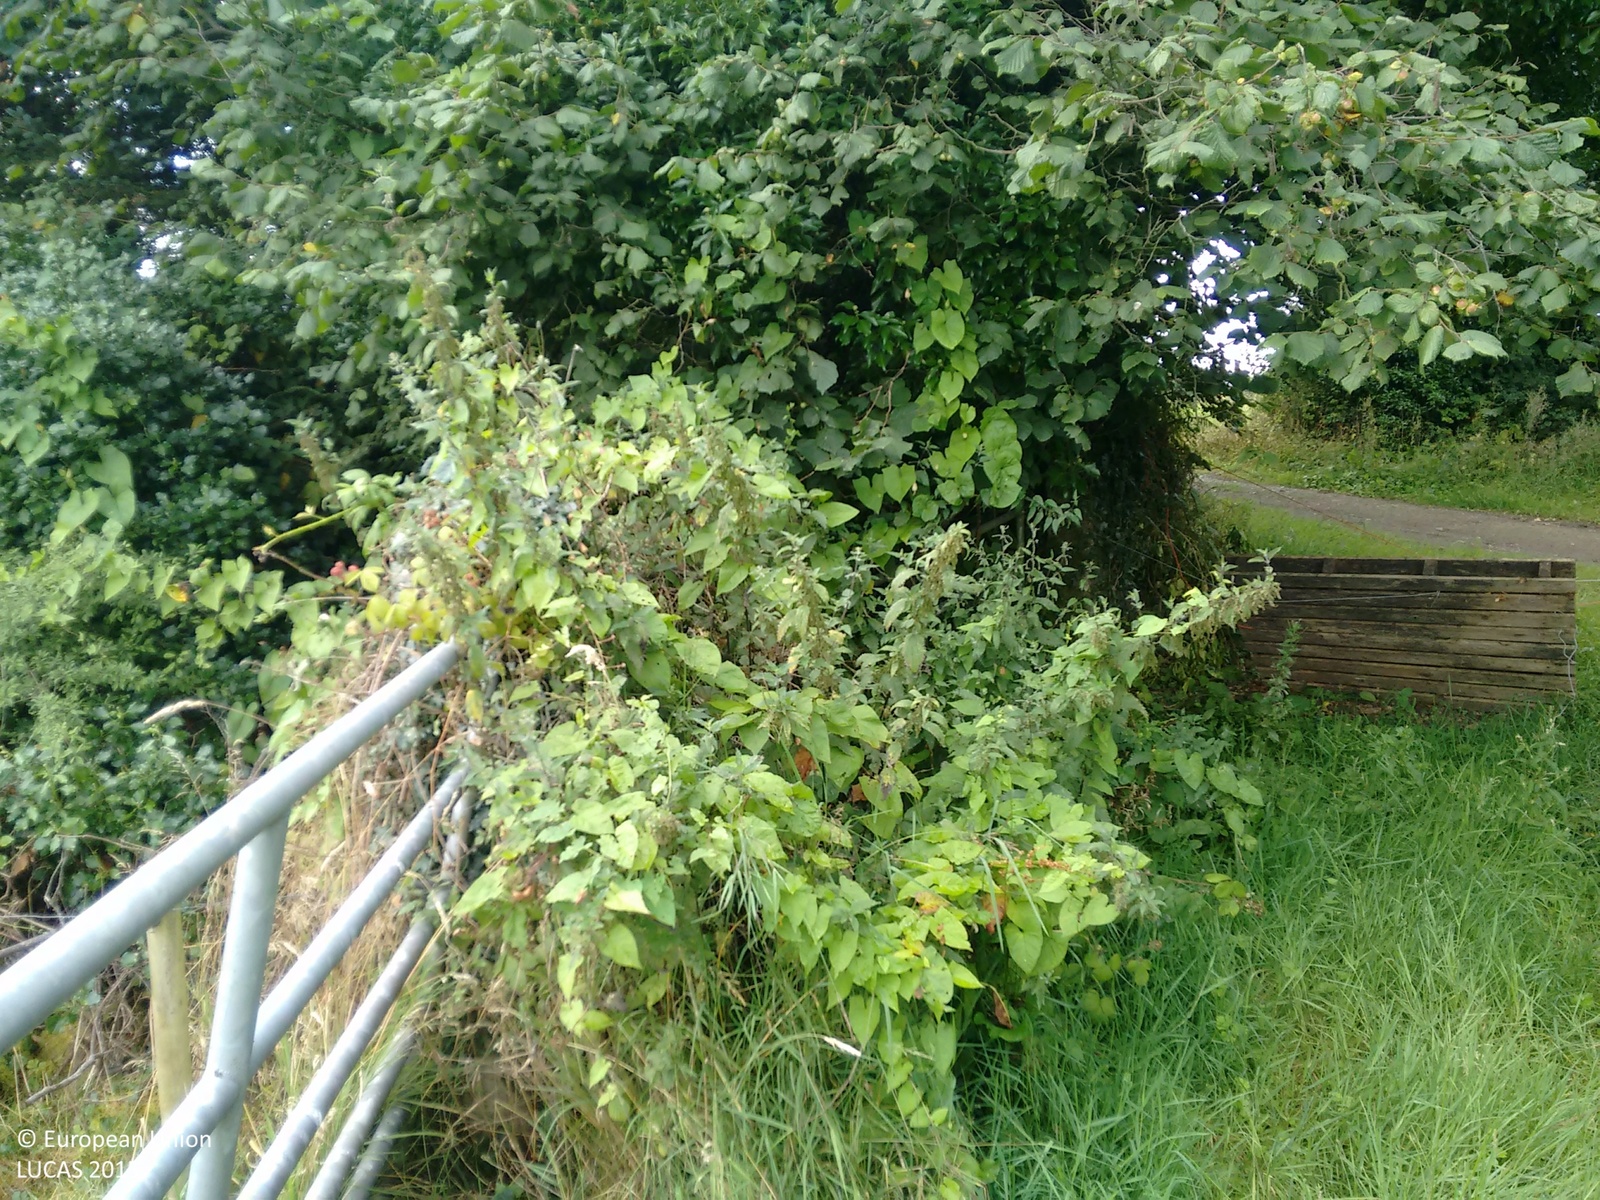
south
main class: Grassland
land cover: Grassland without tree/shrub cover
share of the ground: > 75 %
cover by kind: herbaceous plants 100 %
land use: Agriculture (excluding fallow land and kitchen gardens)
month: August
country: IE
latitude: 52.5129
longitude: -6.6503
